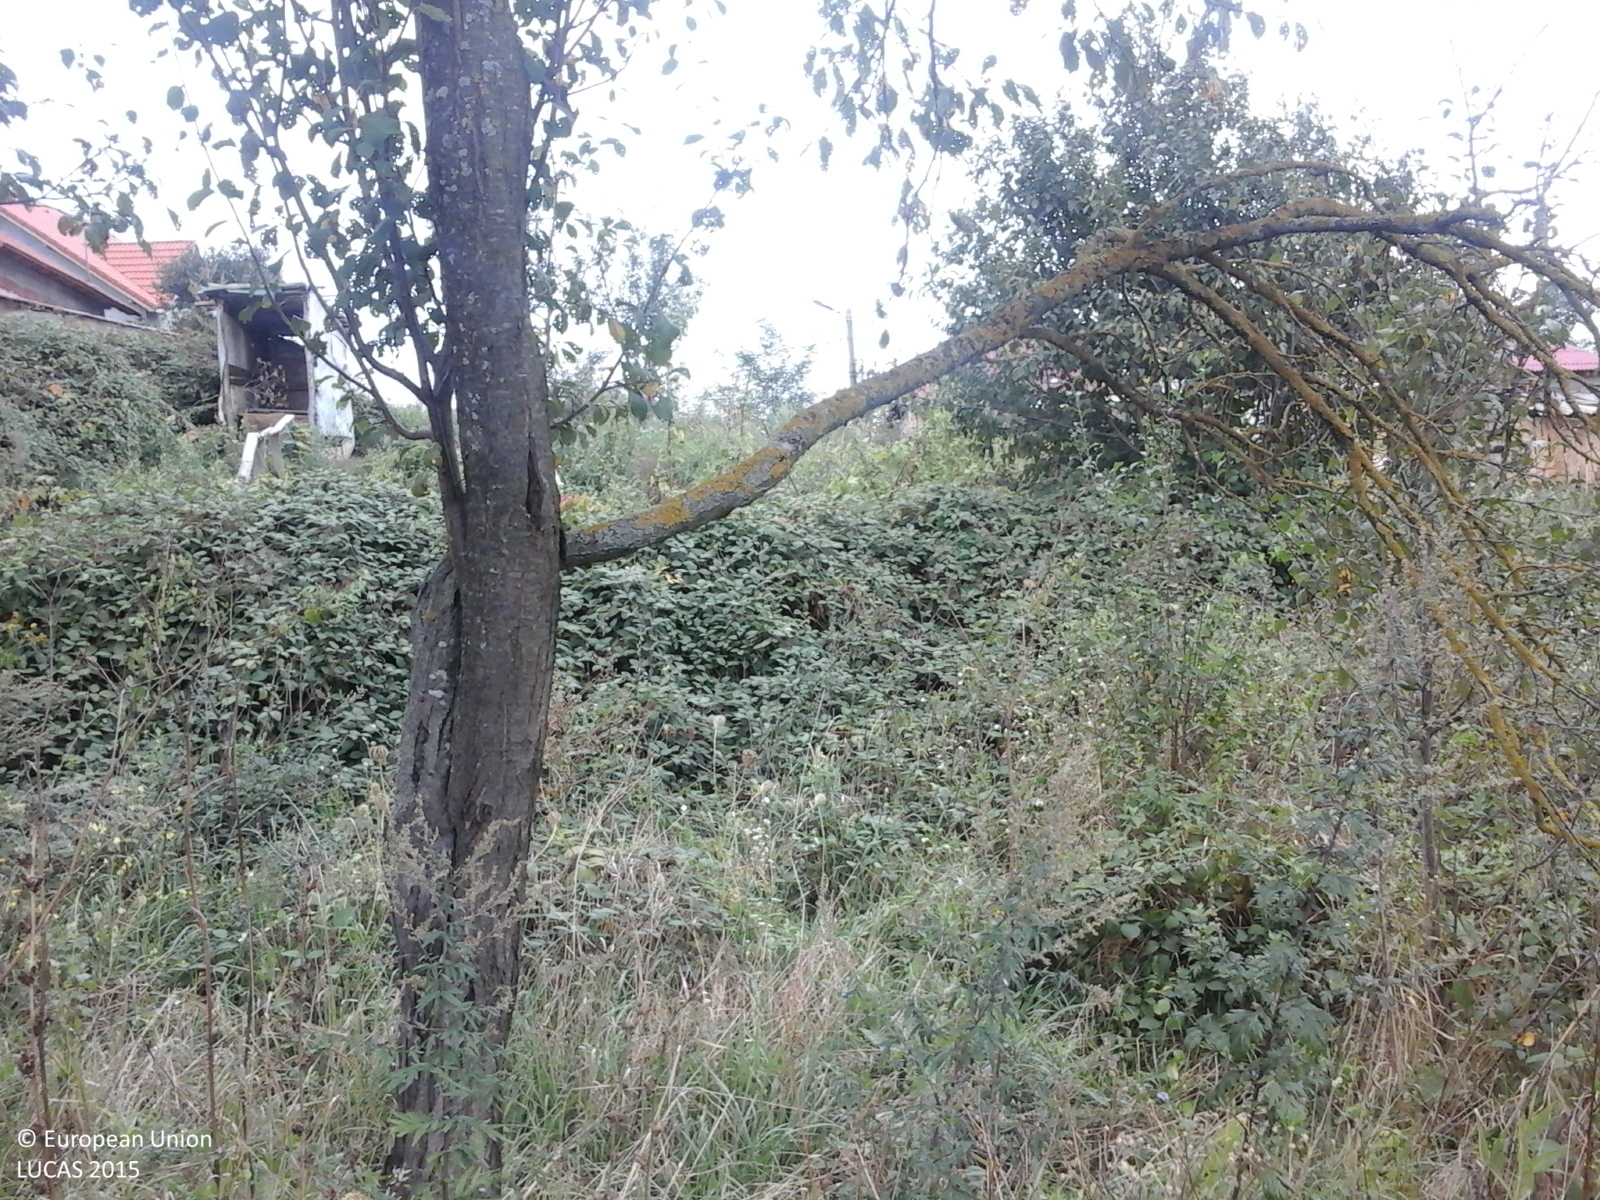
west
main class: Cropland
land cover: Other fruit trees and berries
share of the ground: 50 - 75 %
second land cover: Spontaneously vegetated surfaces
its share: > 75 %
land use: Agriculture (excluding fallow land and kitchen gardens)
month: September
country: RO
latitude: 47.0220
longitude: 22.3002
